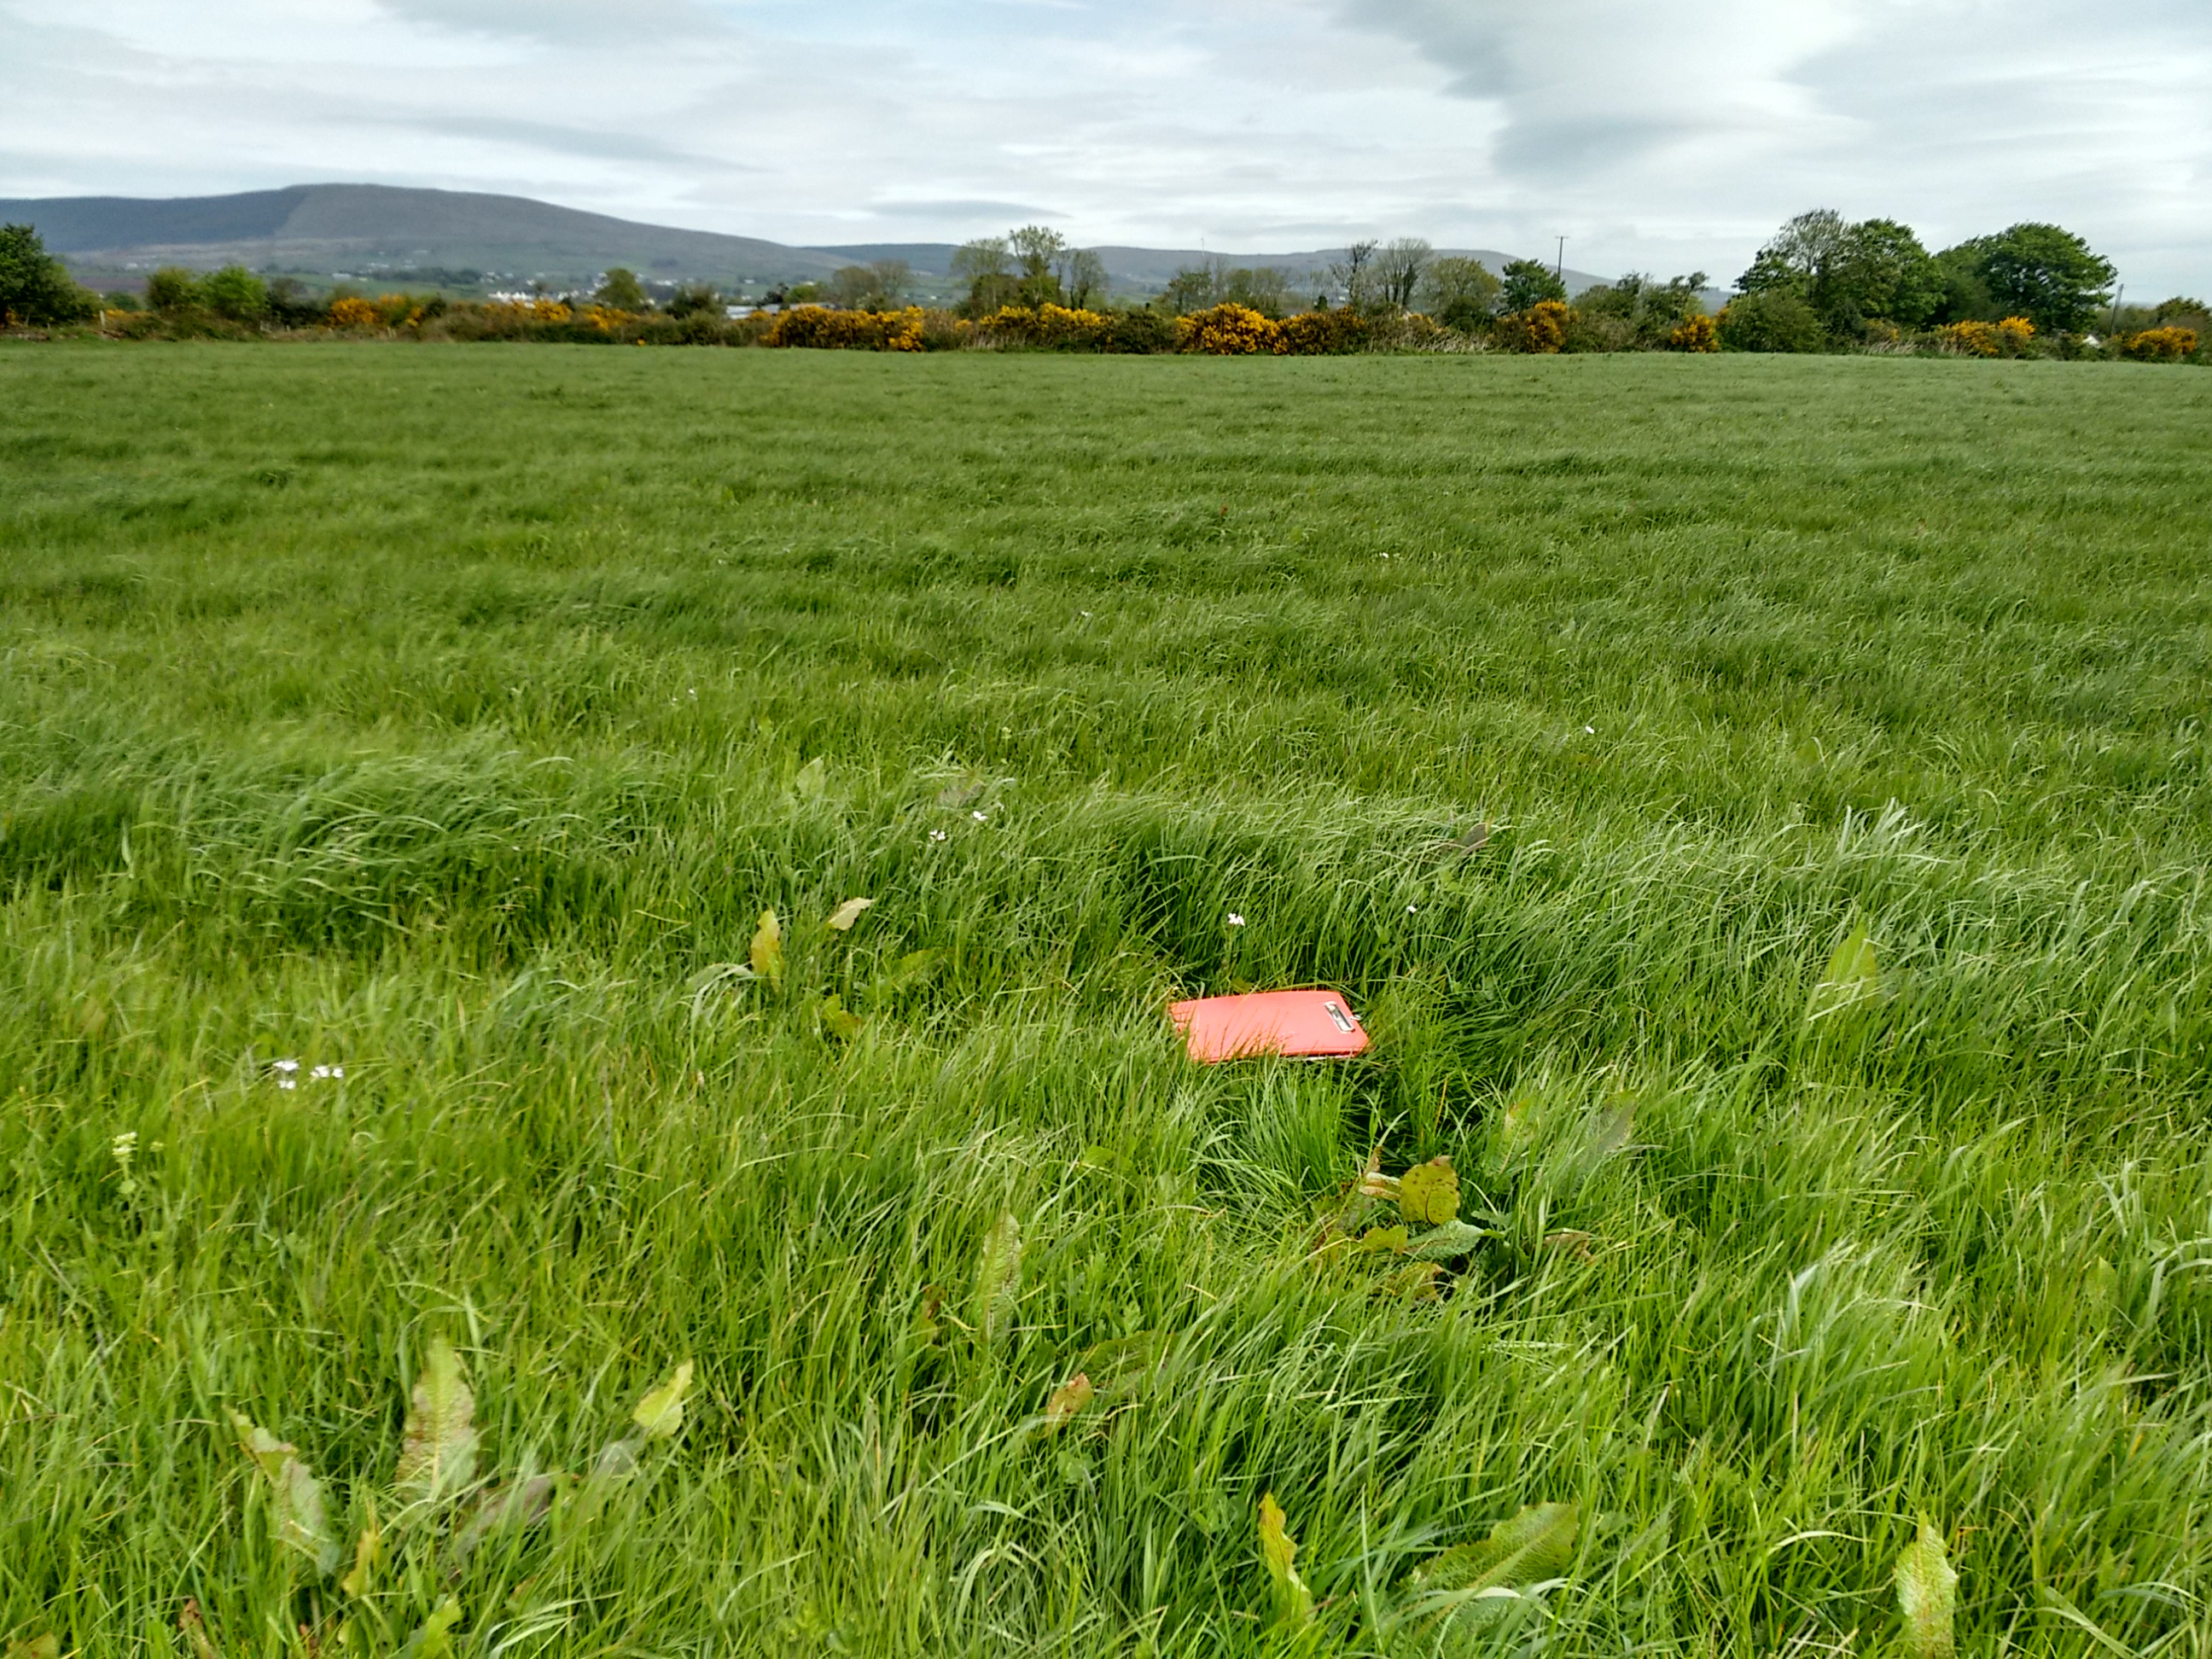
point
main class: Grassland
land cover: Grassland without tree/shrub cover
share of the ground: > 75 %
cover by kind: herbaceous plants 100 %
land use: Agriculture (excluding fallow land and kitchen gardens)
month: May
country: GB
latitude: 55.0598
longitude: -7.2583
